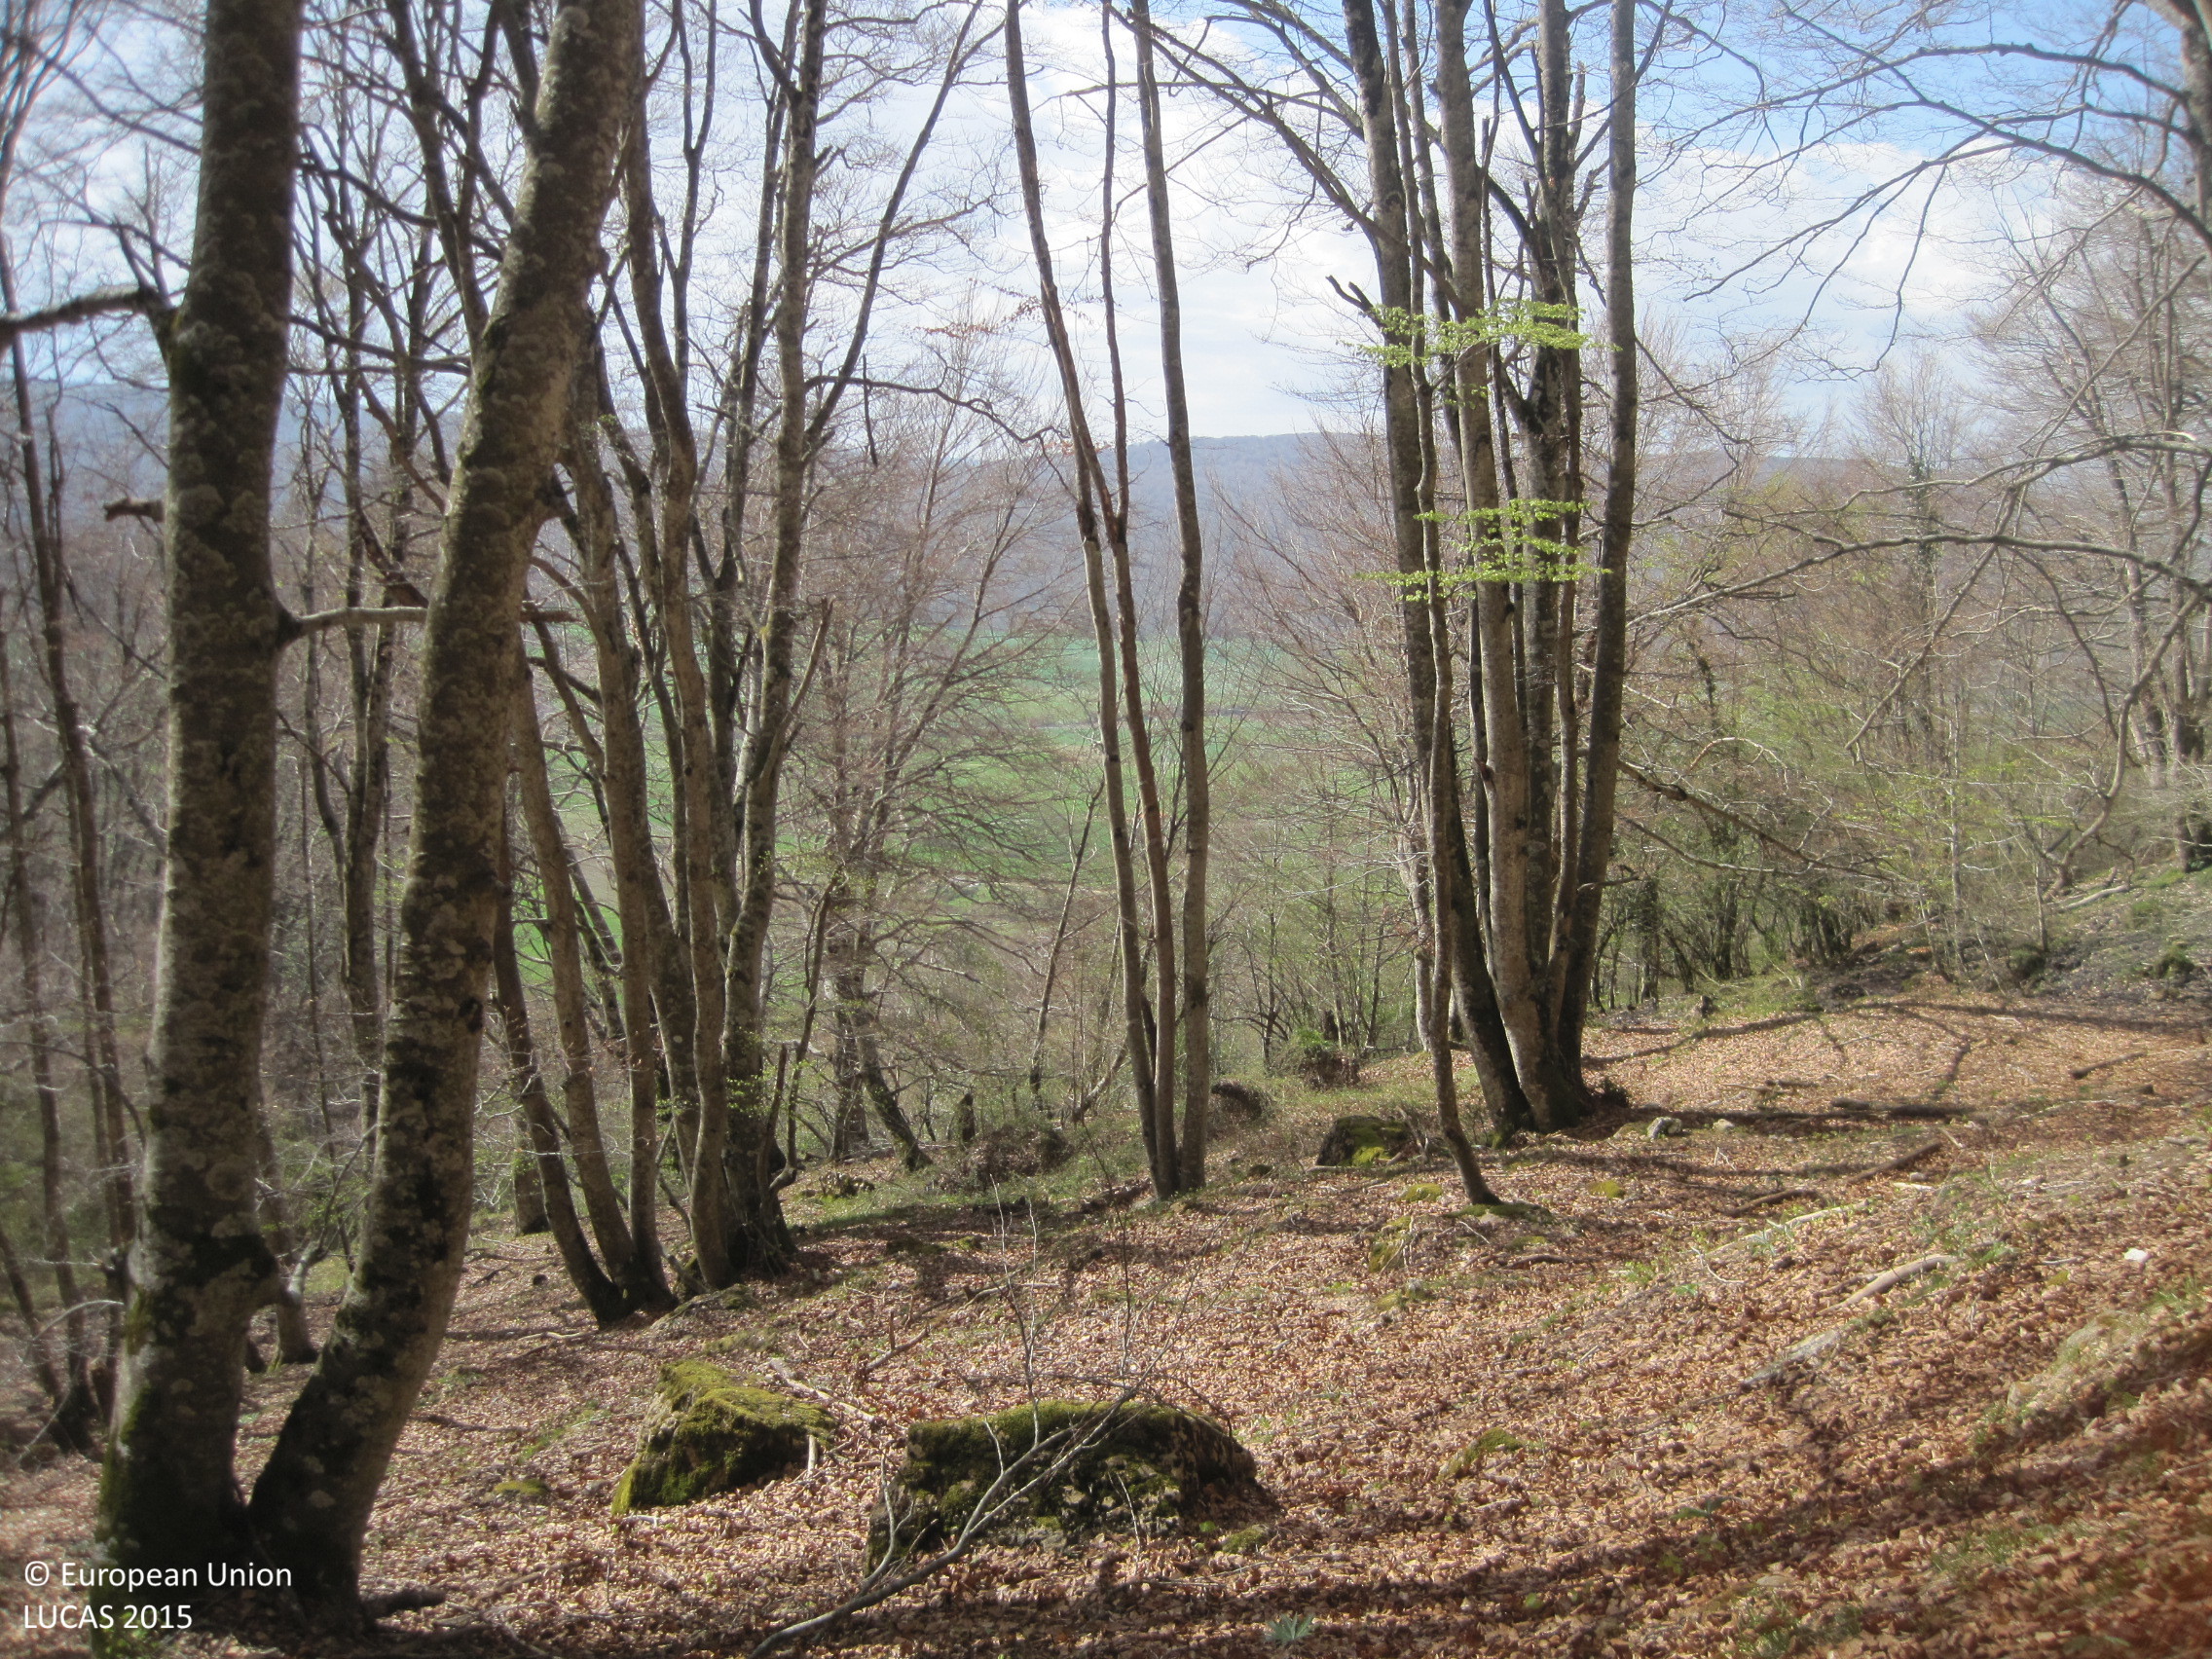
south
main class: Woodland
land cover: Broadleaved woodland
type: beech forest
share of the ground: > 75 %
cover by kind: broadleaved forest trees 100 %
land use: Forestry
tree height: > 5 m
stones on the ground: < 10 %
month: April
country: ES
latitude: 42.7734
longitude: -2.3294
